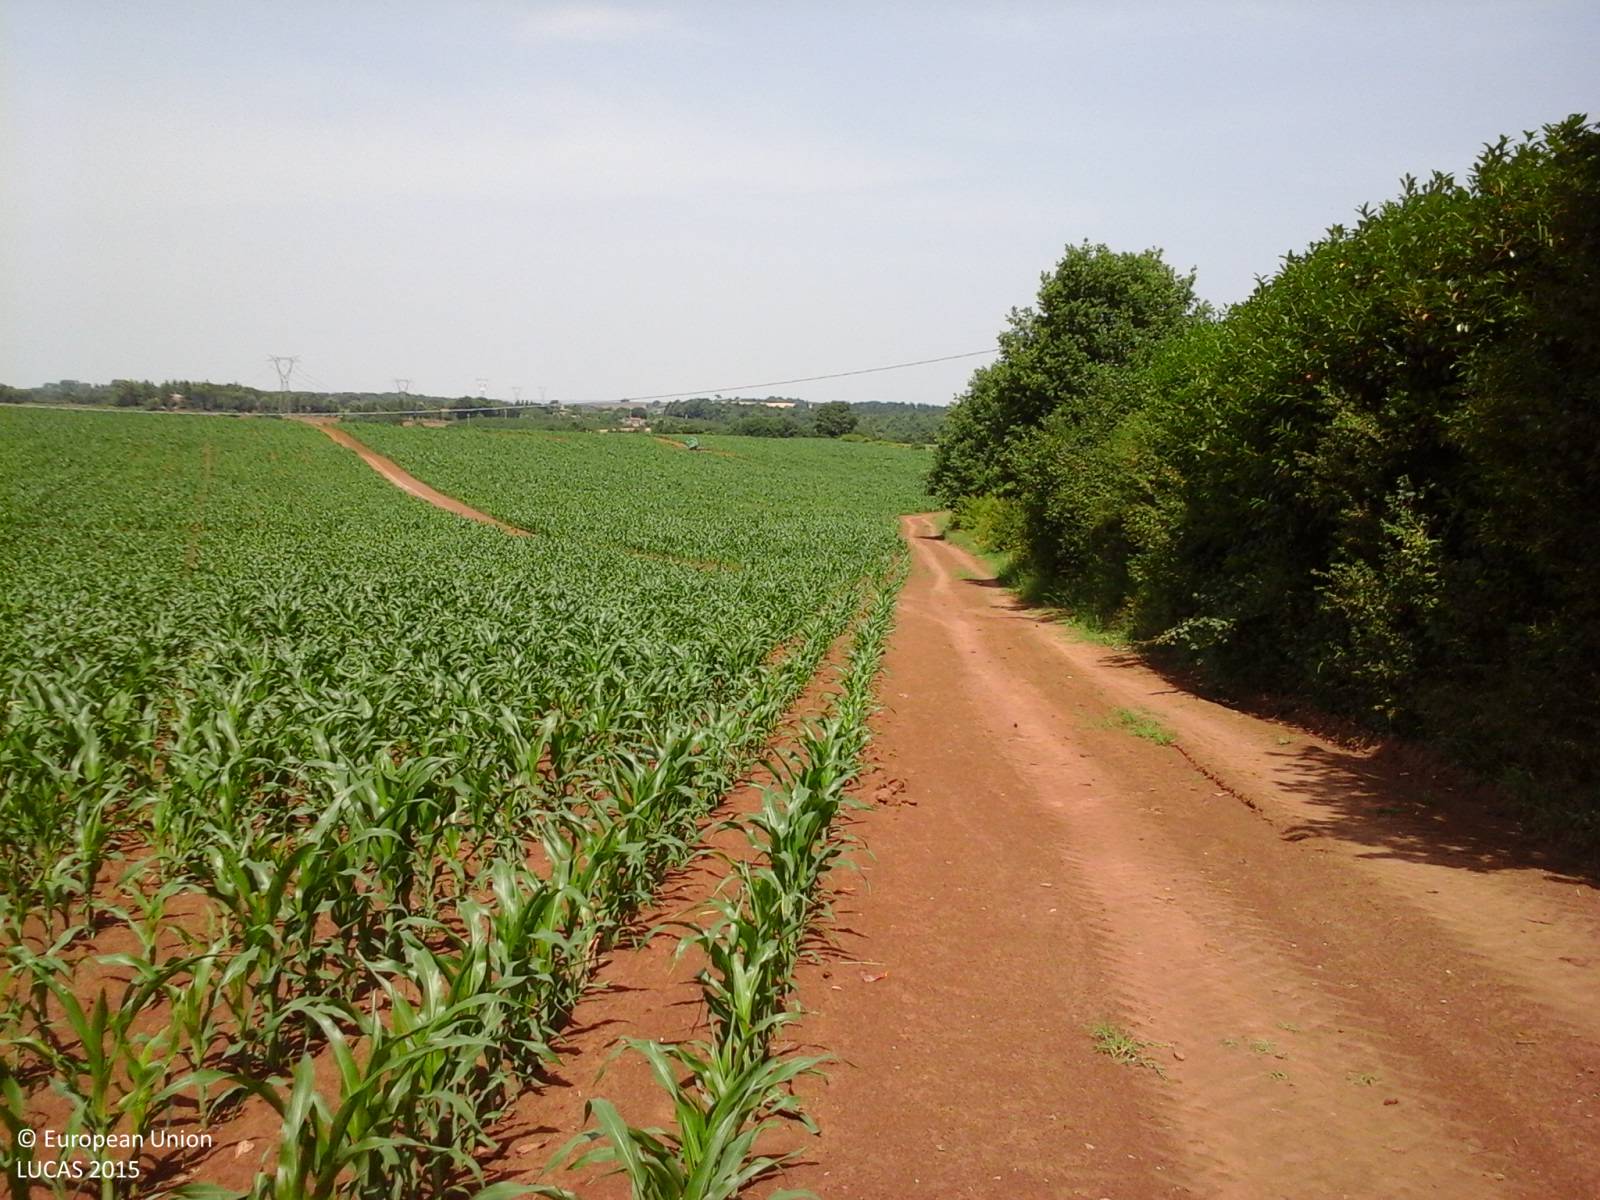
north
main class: Cropland
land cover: Maize
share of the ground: > 75 %
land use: Agriculture (excluding fallow land and kitchen gardens)
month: June
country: IT
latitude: 42.4480
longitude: 12.2660
